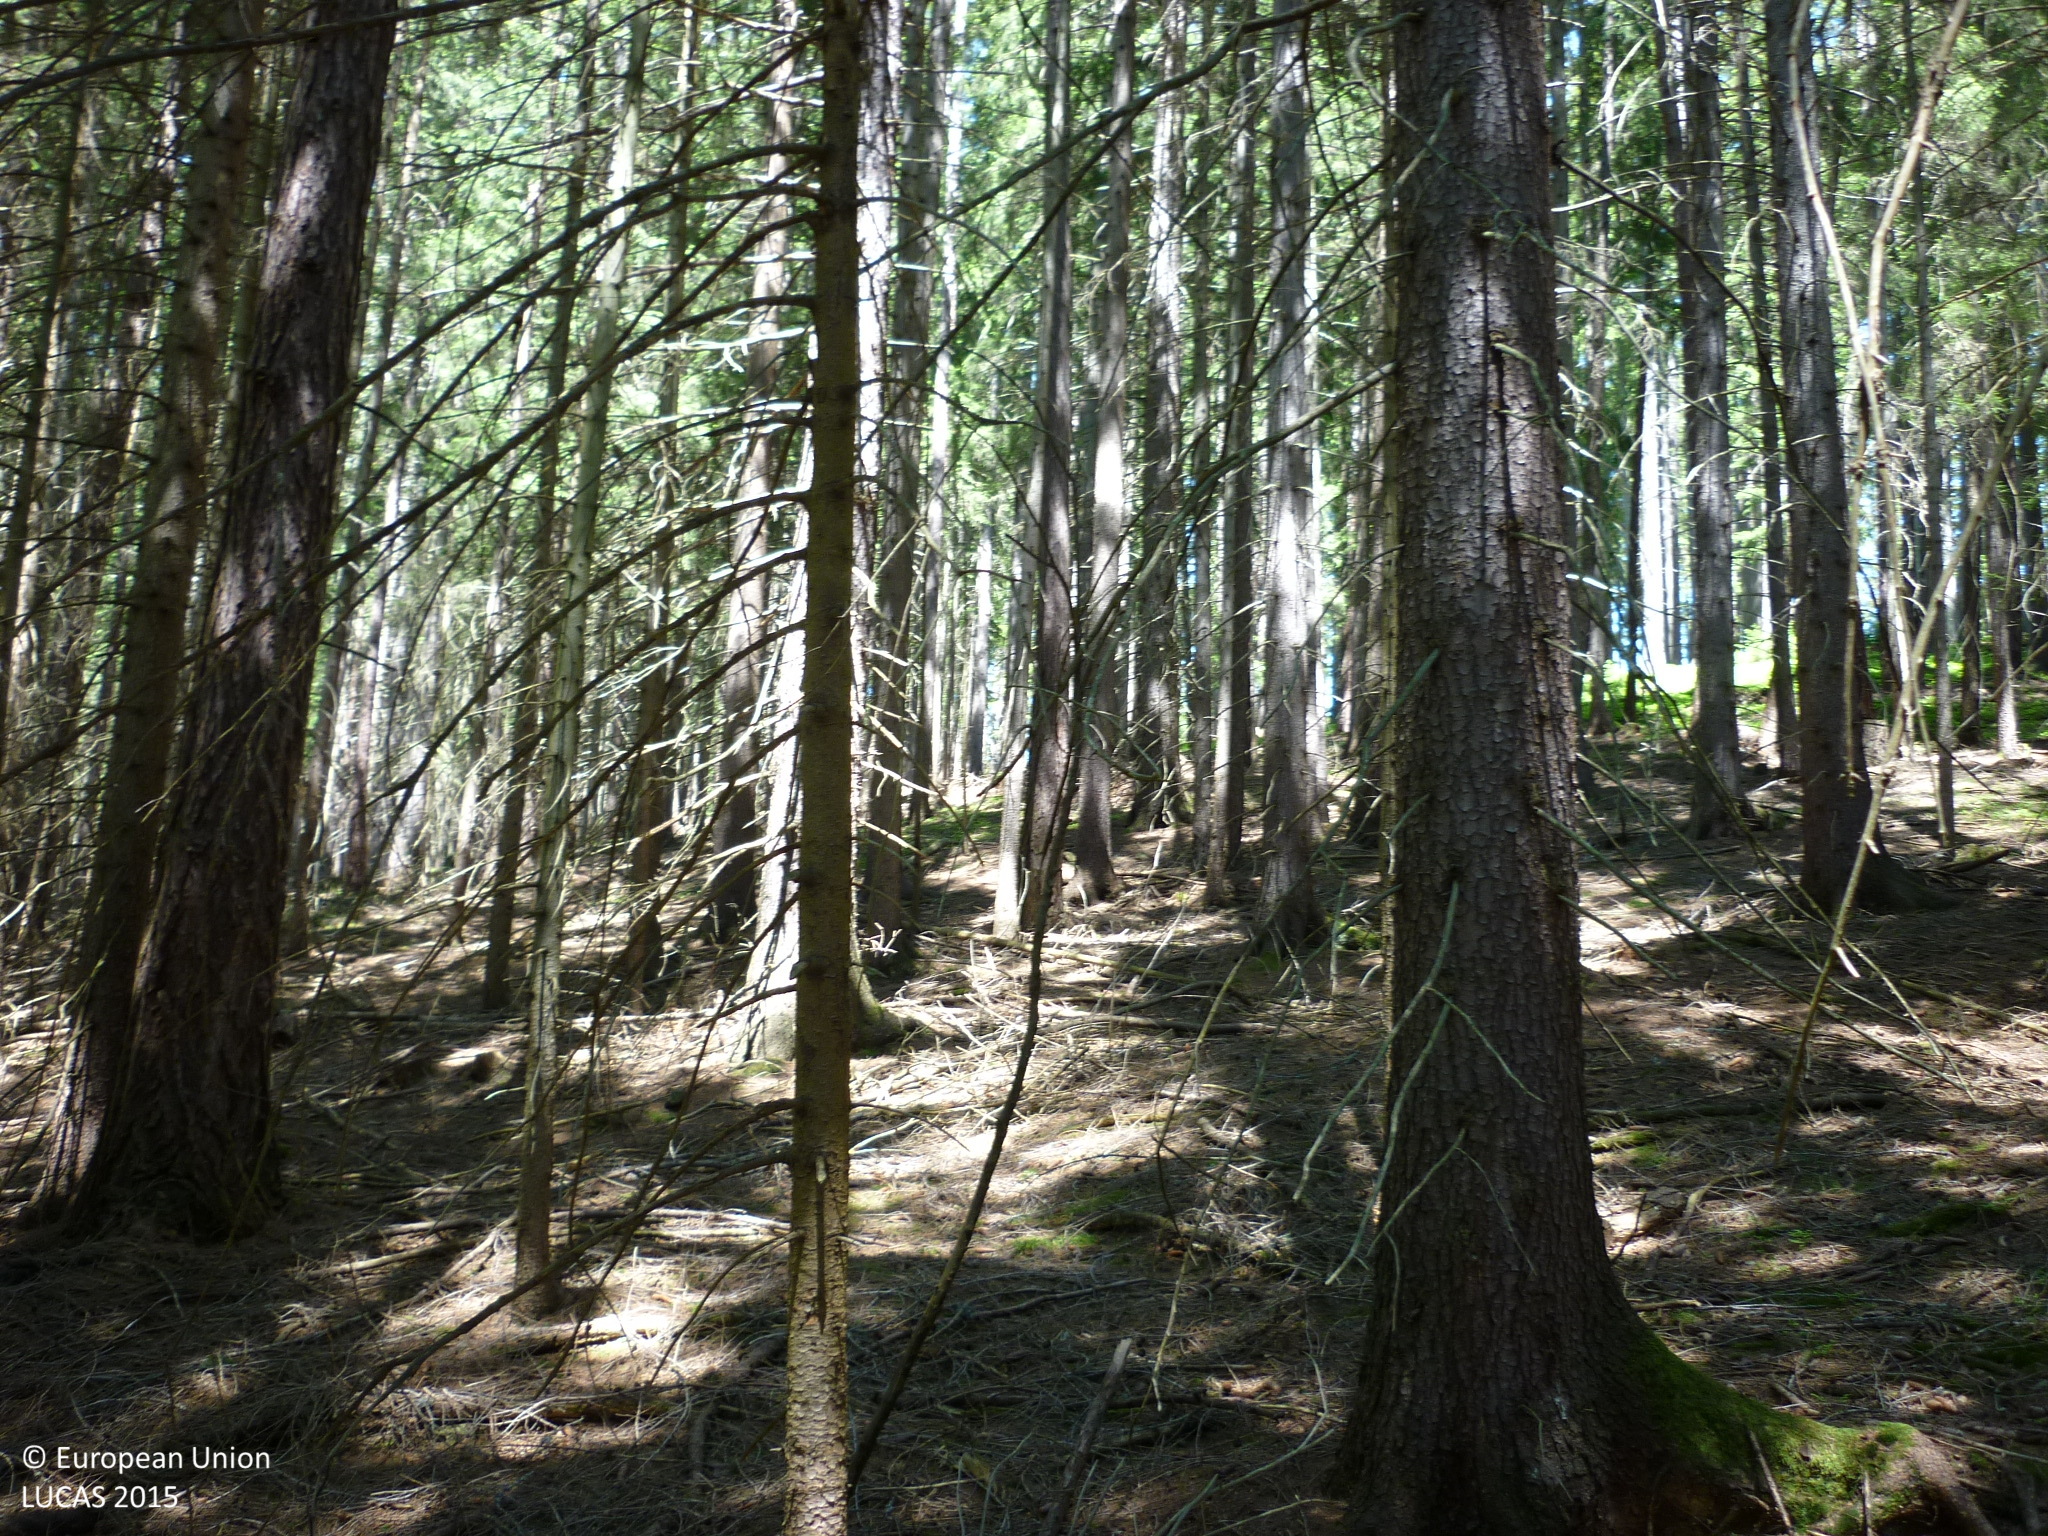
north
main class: Woodland
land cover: Spruce dominated coniferous woodland
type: alpine coniferous forest
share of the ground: > 75 %
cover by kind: coniferous forest trees 100 %
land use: Forestry
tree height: > 5 m
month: May
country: AT
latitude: 47.3042
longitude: 14.8798
